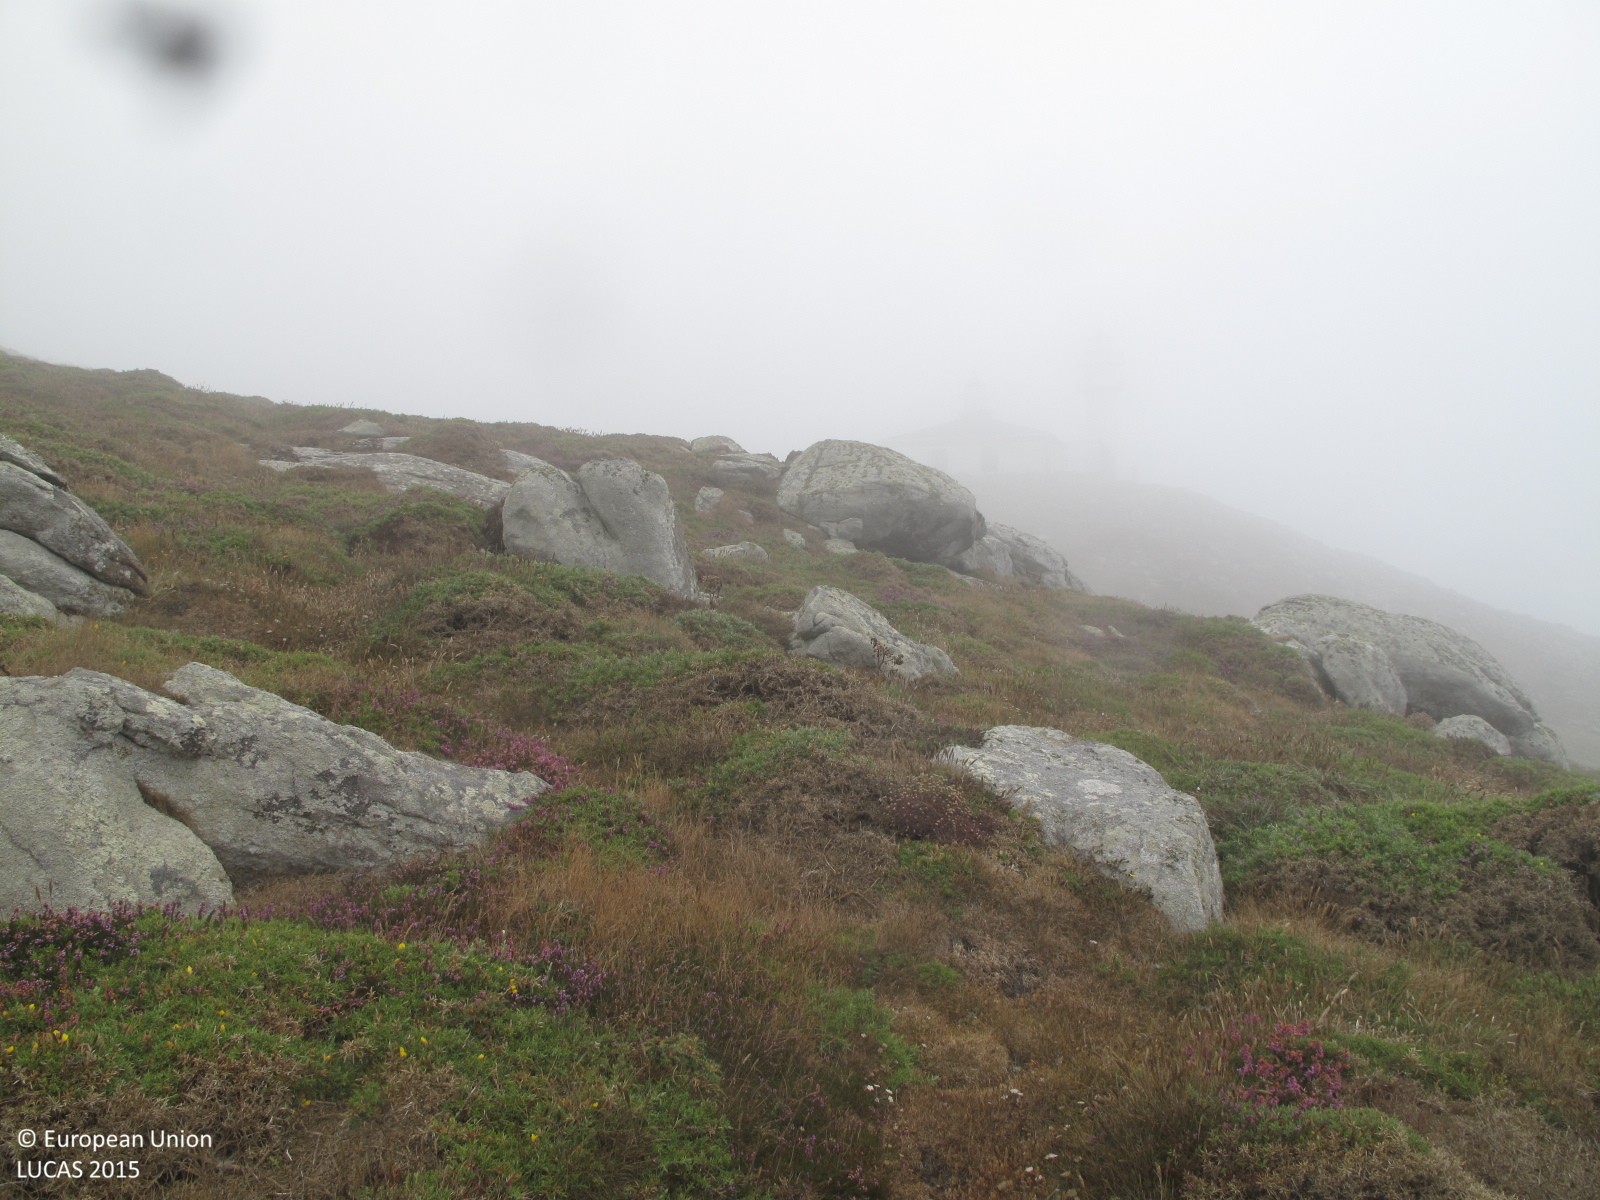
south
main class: Shrubland
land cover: Shrubland without tree cover
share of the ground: 50 - 75 %
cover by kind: shrubs 70 %, herbaceous plants 10 %, lichens and mosses 10 %, consolidated bare surface 10 %
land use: Semi-natural and natural areas not in use
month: July
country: ES
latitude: 43.0544
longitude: -9.2973
